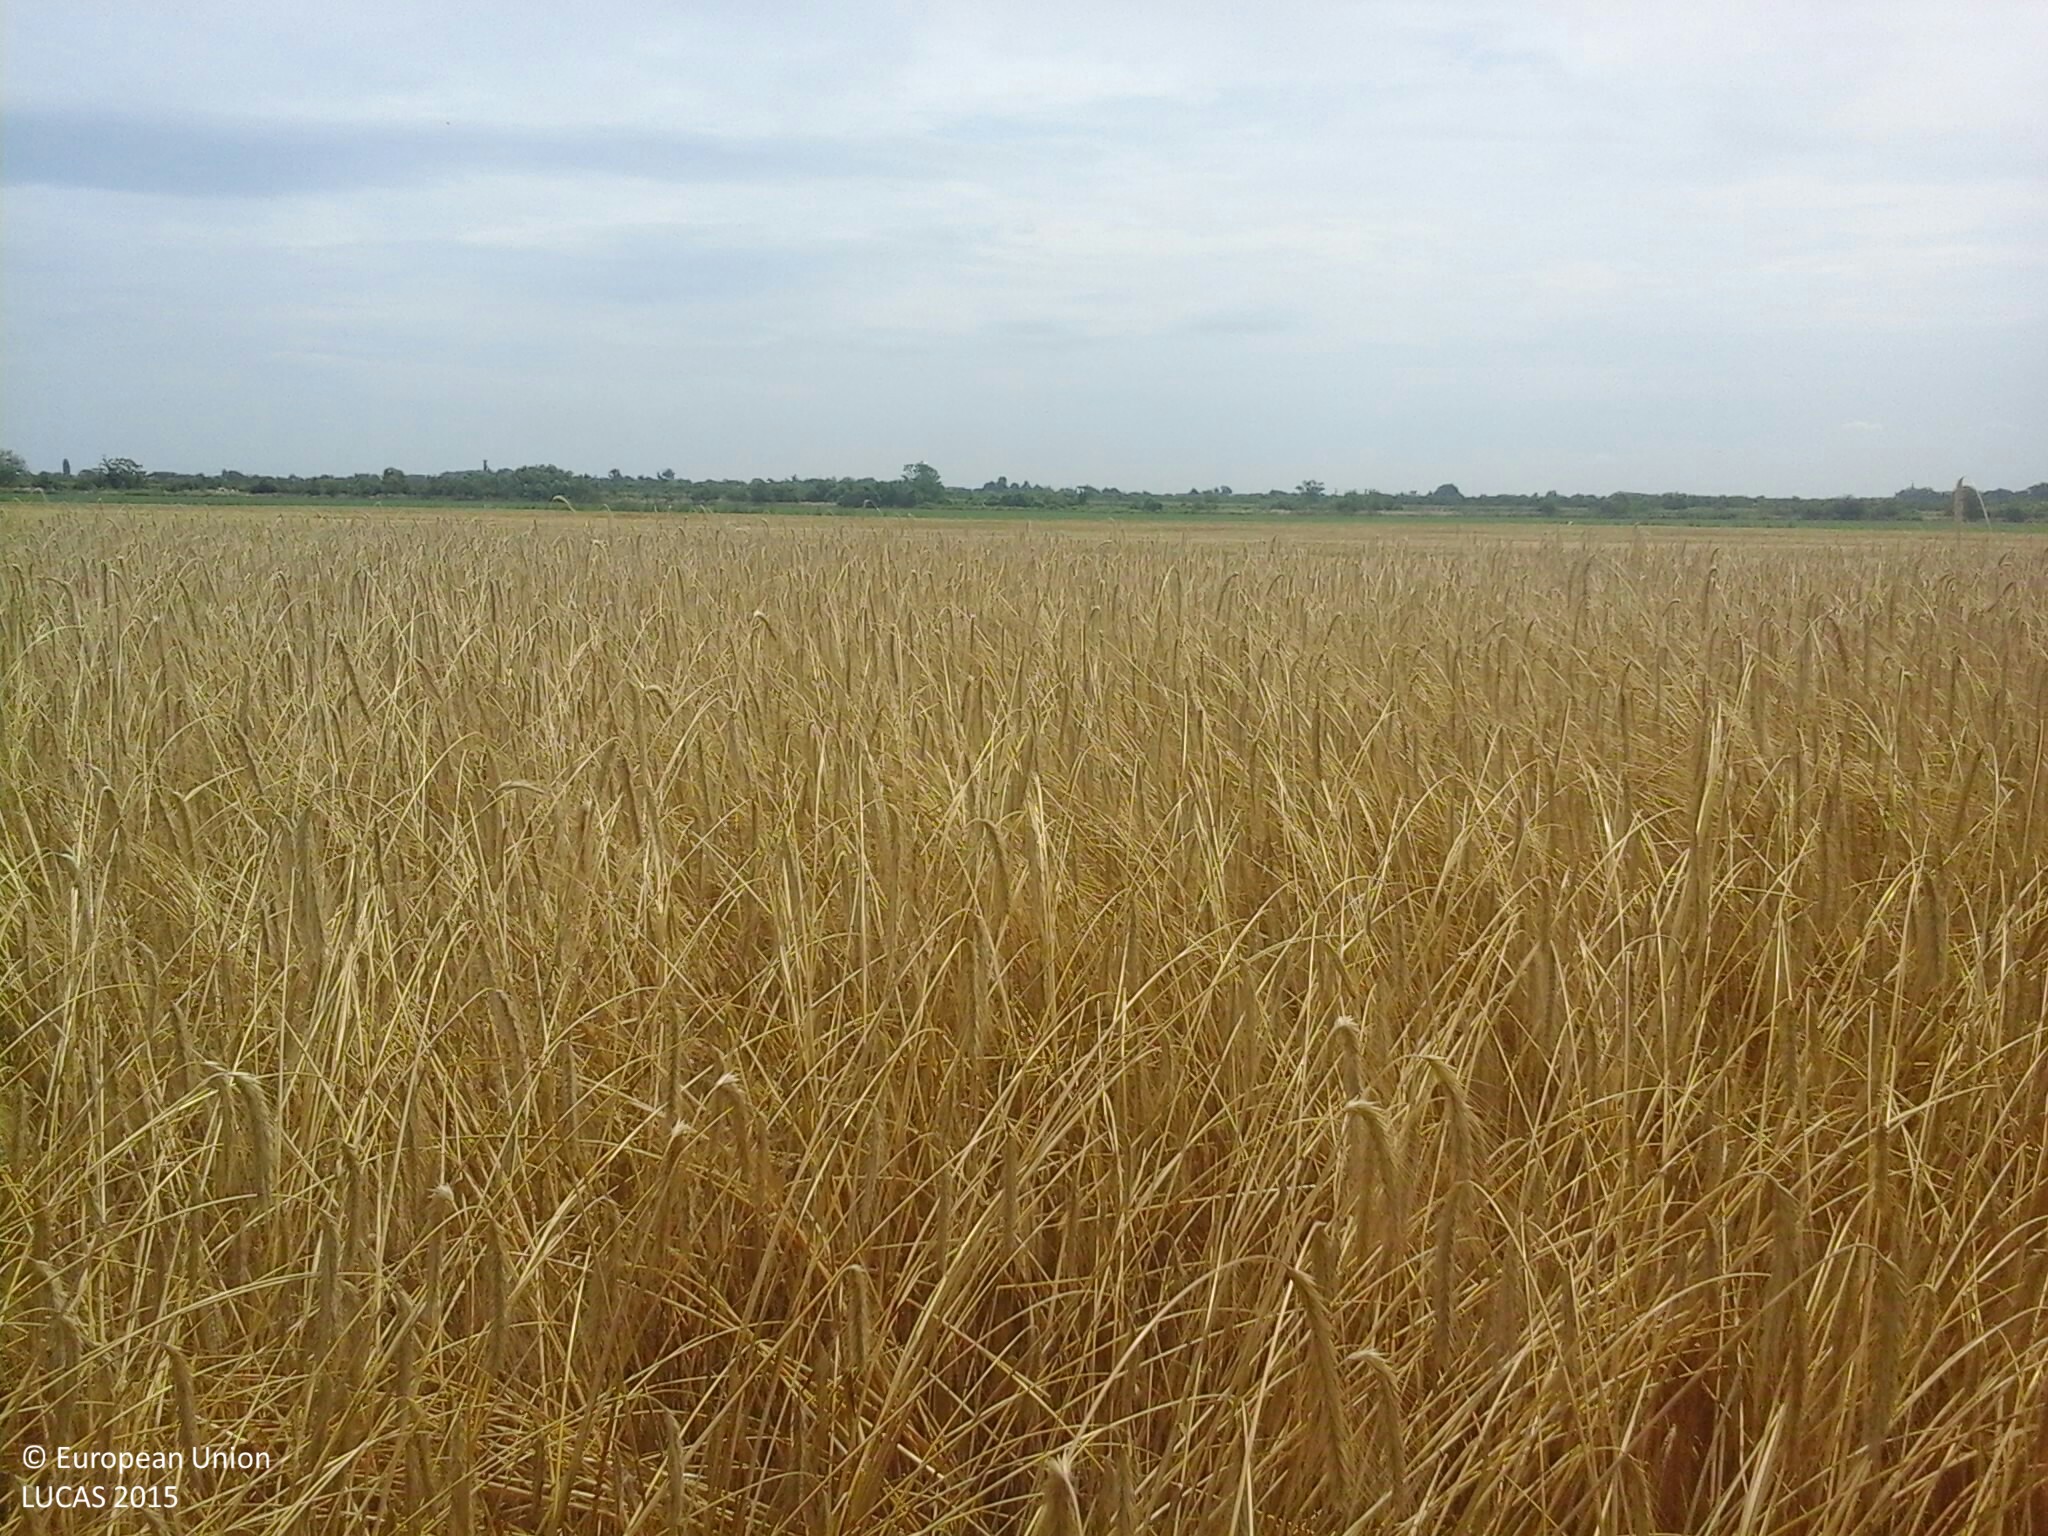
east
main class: Cropland
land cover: Rye
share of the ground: > 75 %
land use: Agriculture (excluding fallow land and kitchen gardens)
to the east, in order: Rye; Common wheat; Tracks; Common wheat; Lucerne
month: July
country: HU
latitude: 47.1867
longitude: 18.9769
